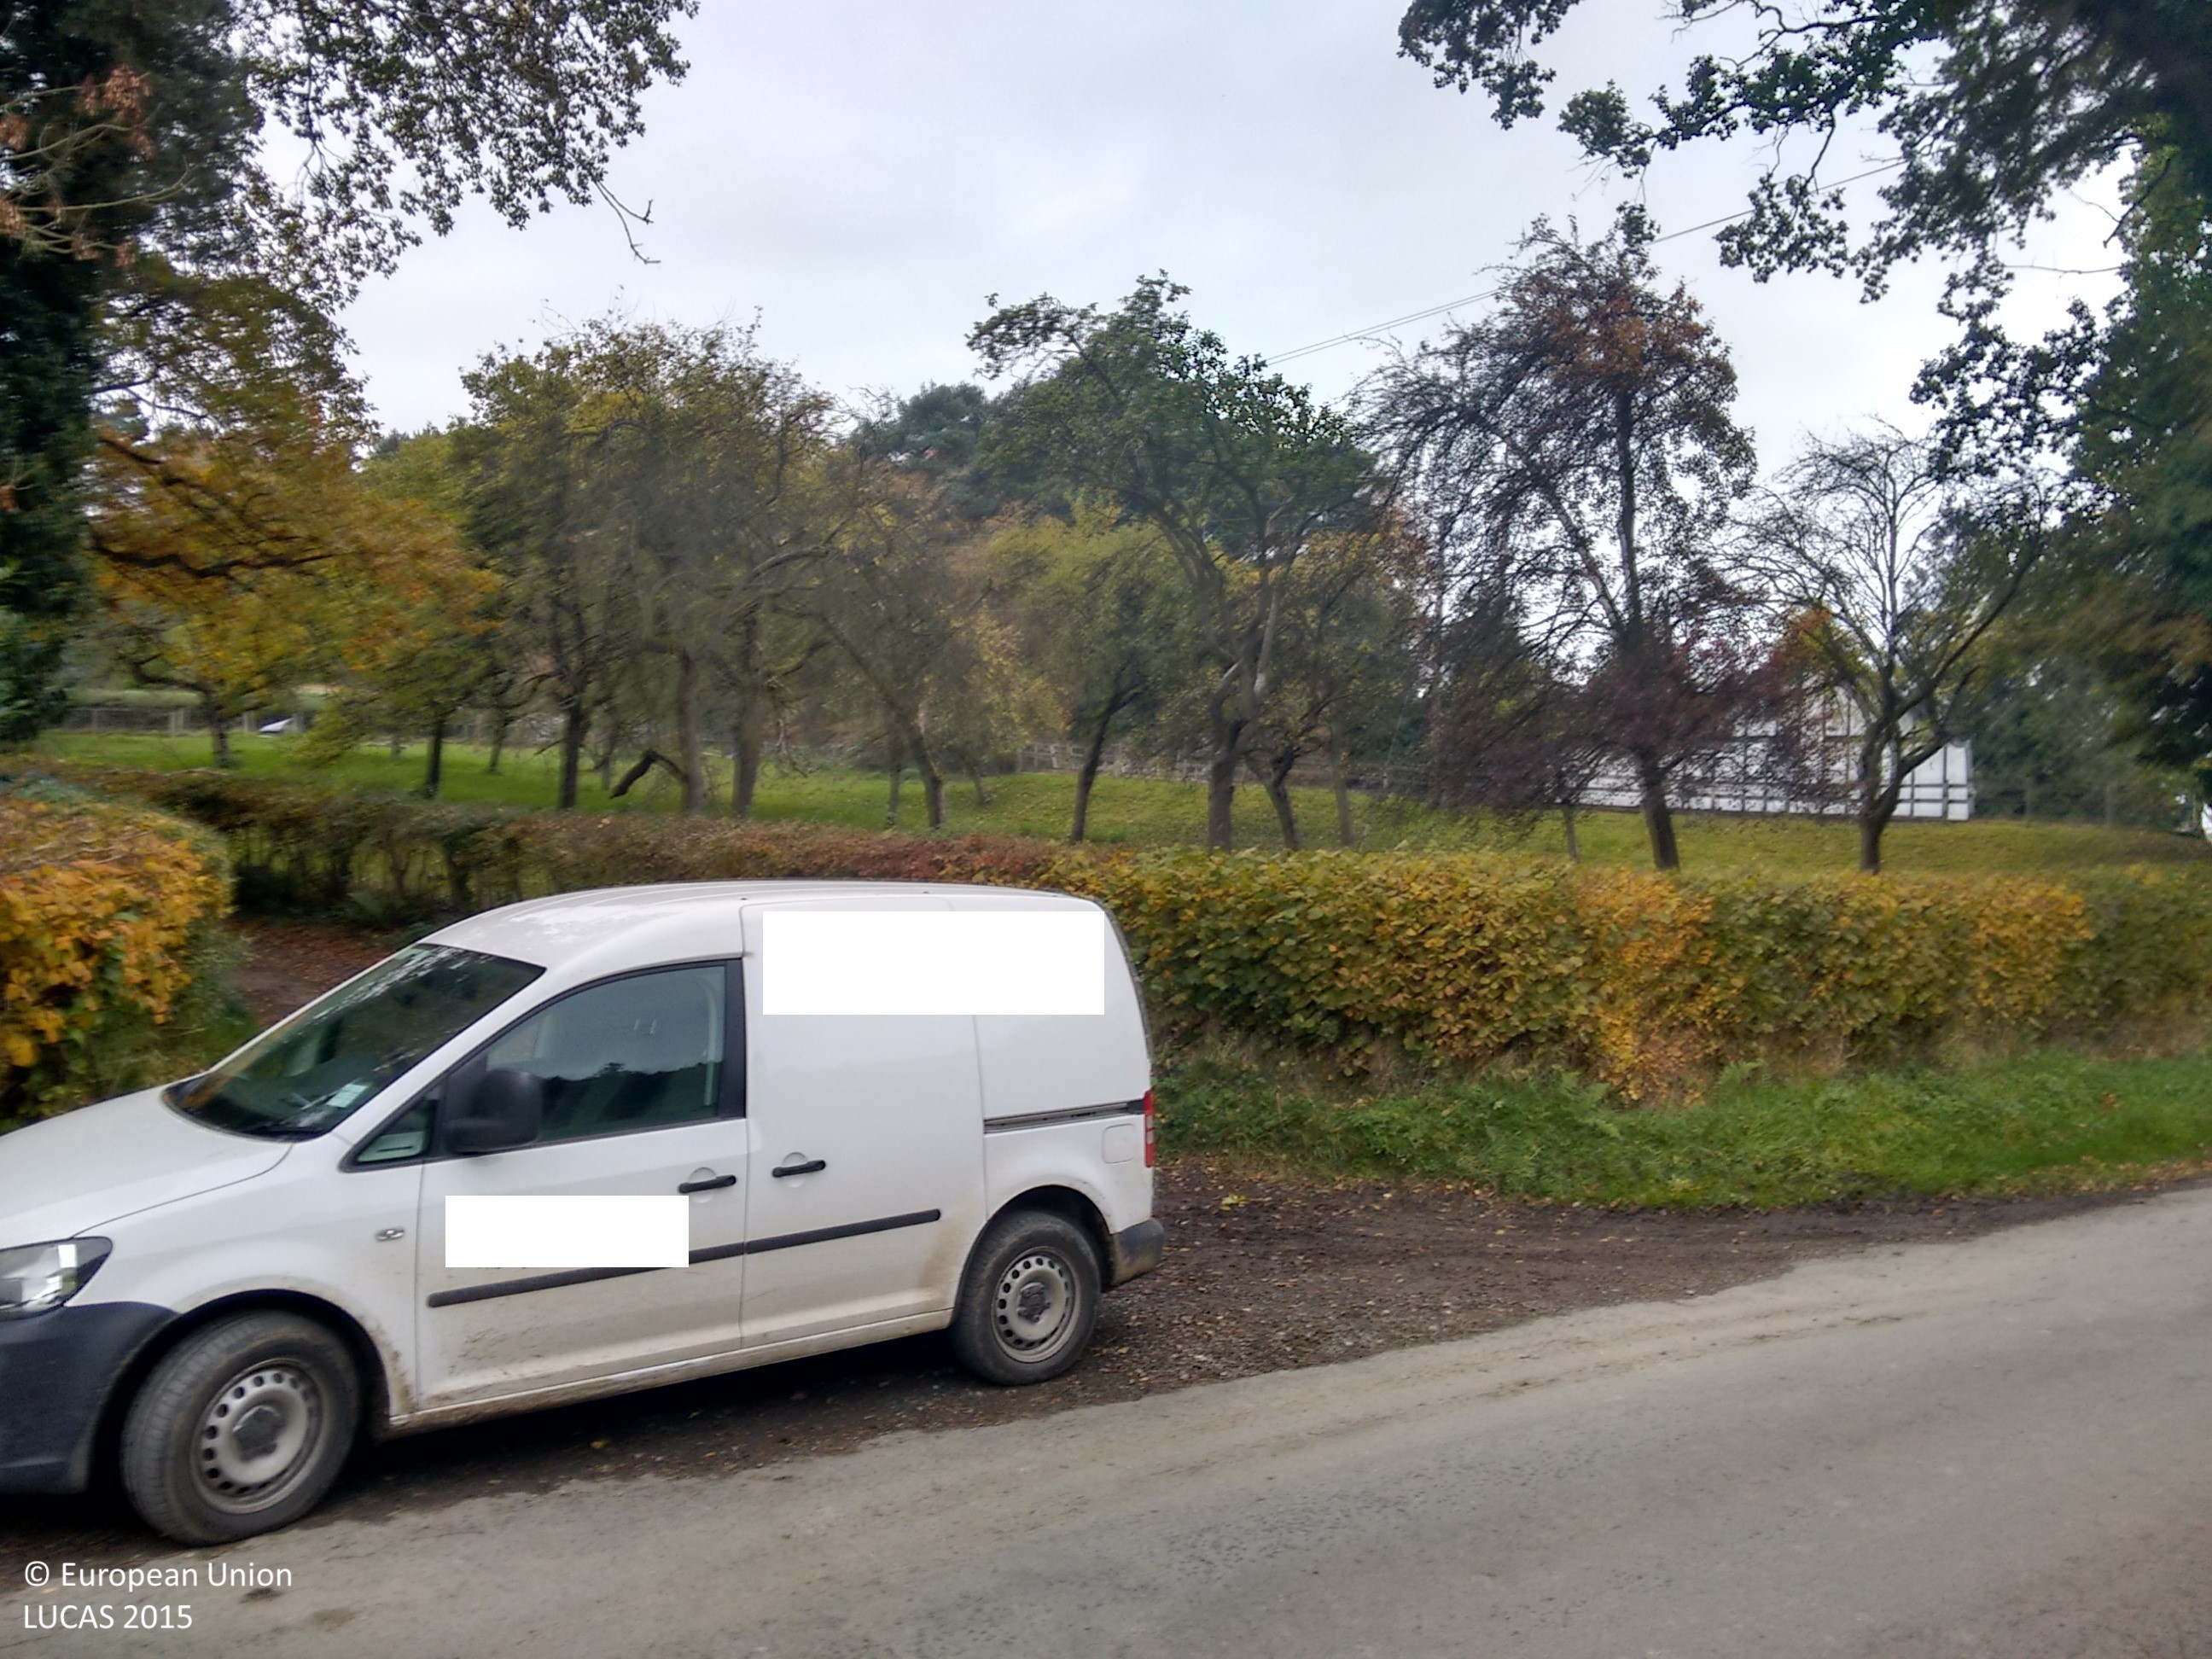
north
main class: Grassland
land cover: Grassland without tree/shrub cover
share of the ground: > 75 %
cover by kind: herbaceous plants 100 %
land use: Agriculture (excluding fallow land and kitchen gardens)
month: October
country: GB
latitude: 52.4669
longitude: -2.7741
